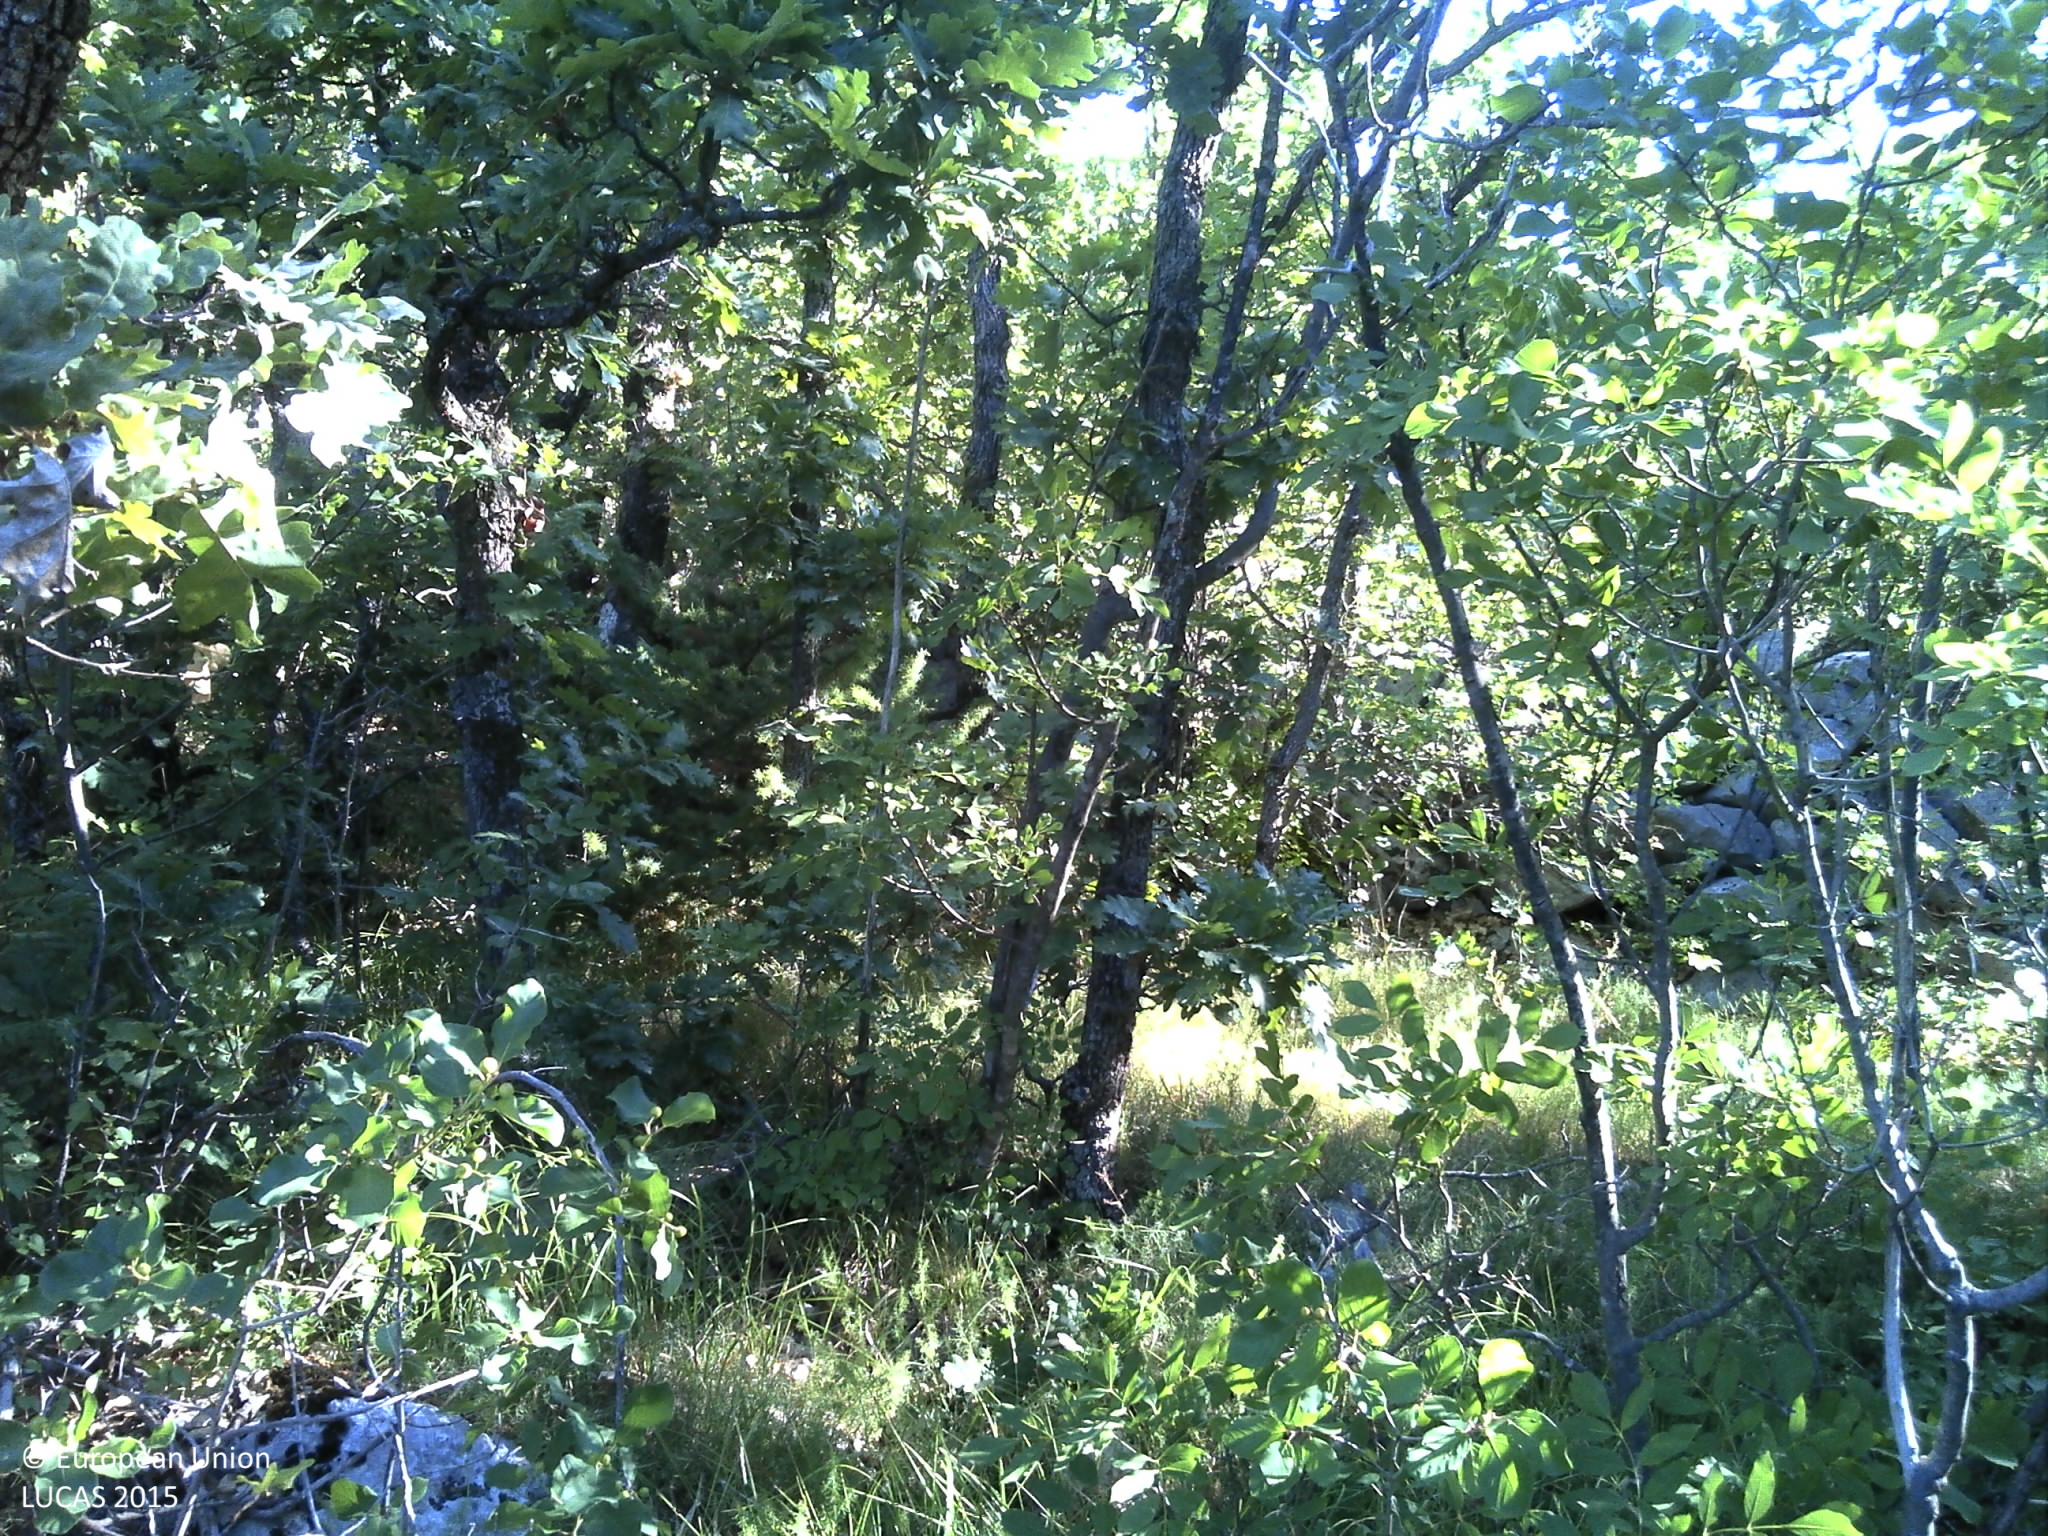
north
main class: Woodland
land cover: Other mixed woodland
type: thermophilous deciduous forest
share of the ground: > 75 %
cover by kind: broadleaved forest trees 55 %, coniferous forest trees 20 %, shrubs 10 %, herbaceous plants 10 %, consolidated bare surface 5 %
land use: Semi-natural and natural areas not in use
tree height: > 5 m
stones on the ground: < 10 %
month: July
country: HR
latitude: 43.5392
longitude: 16.9344
